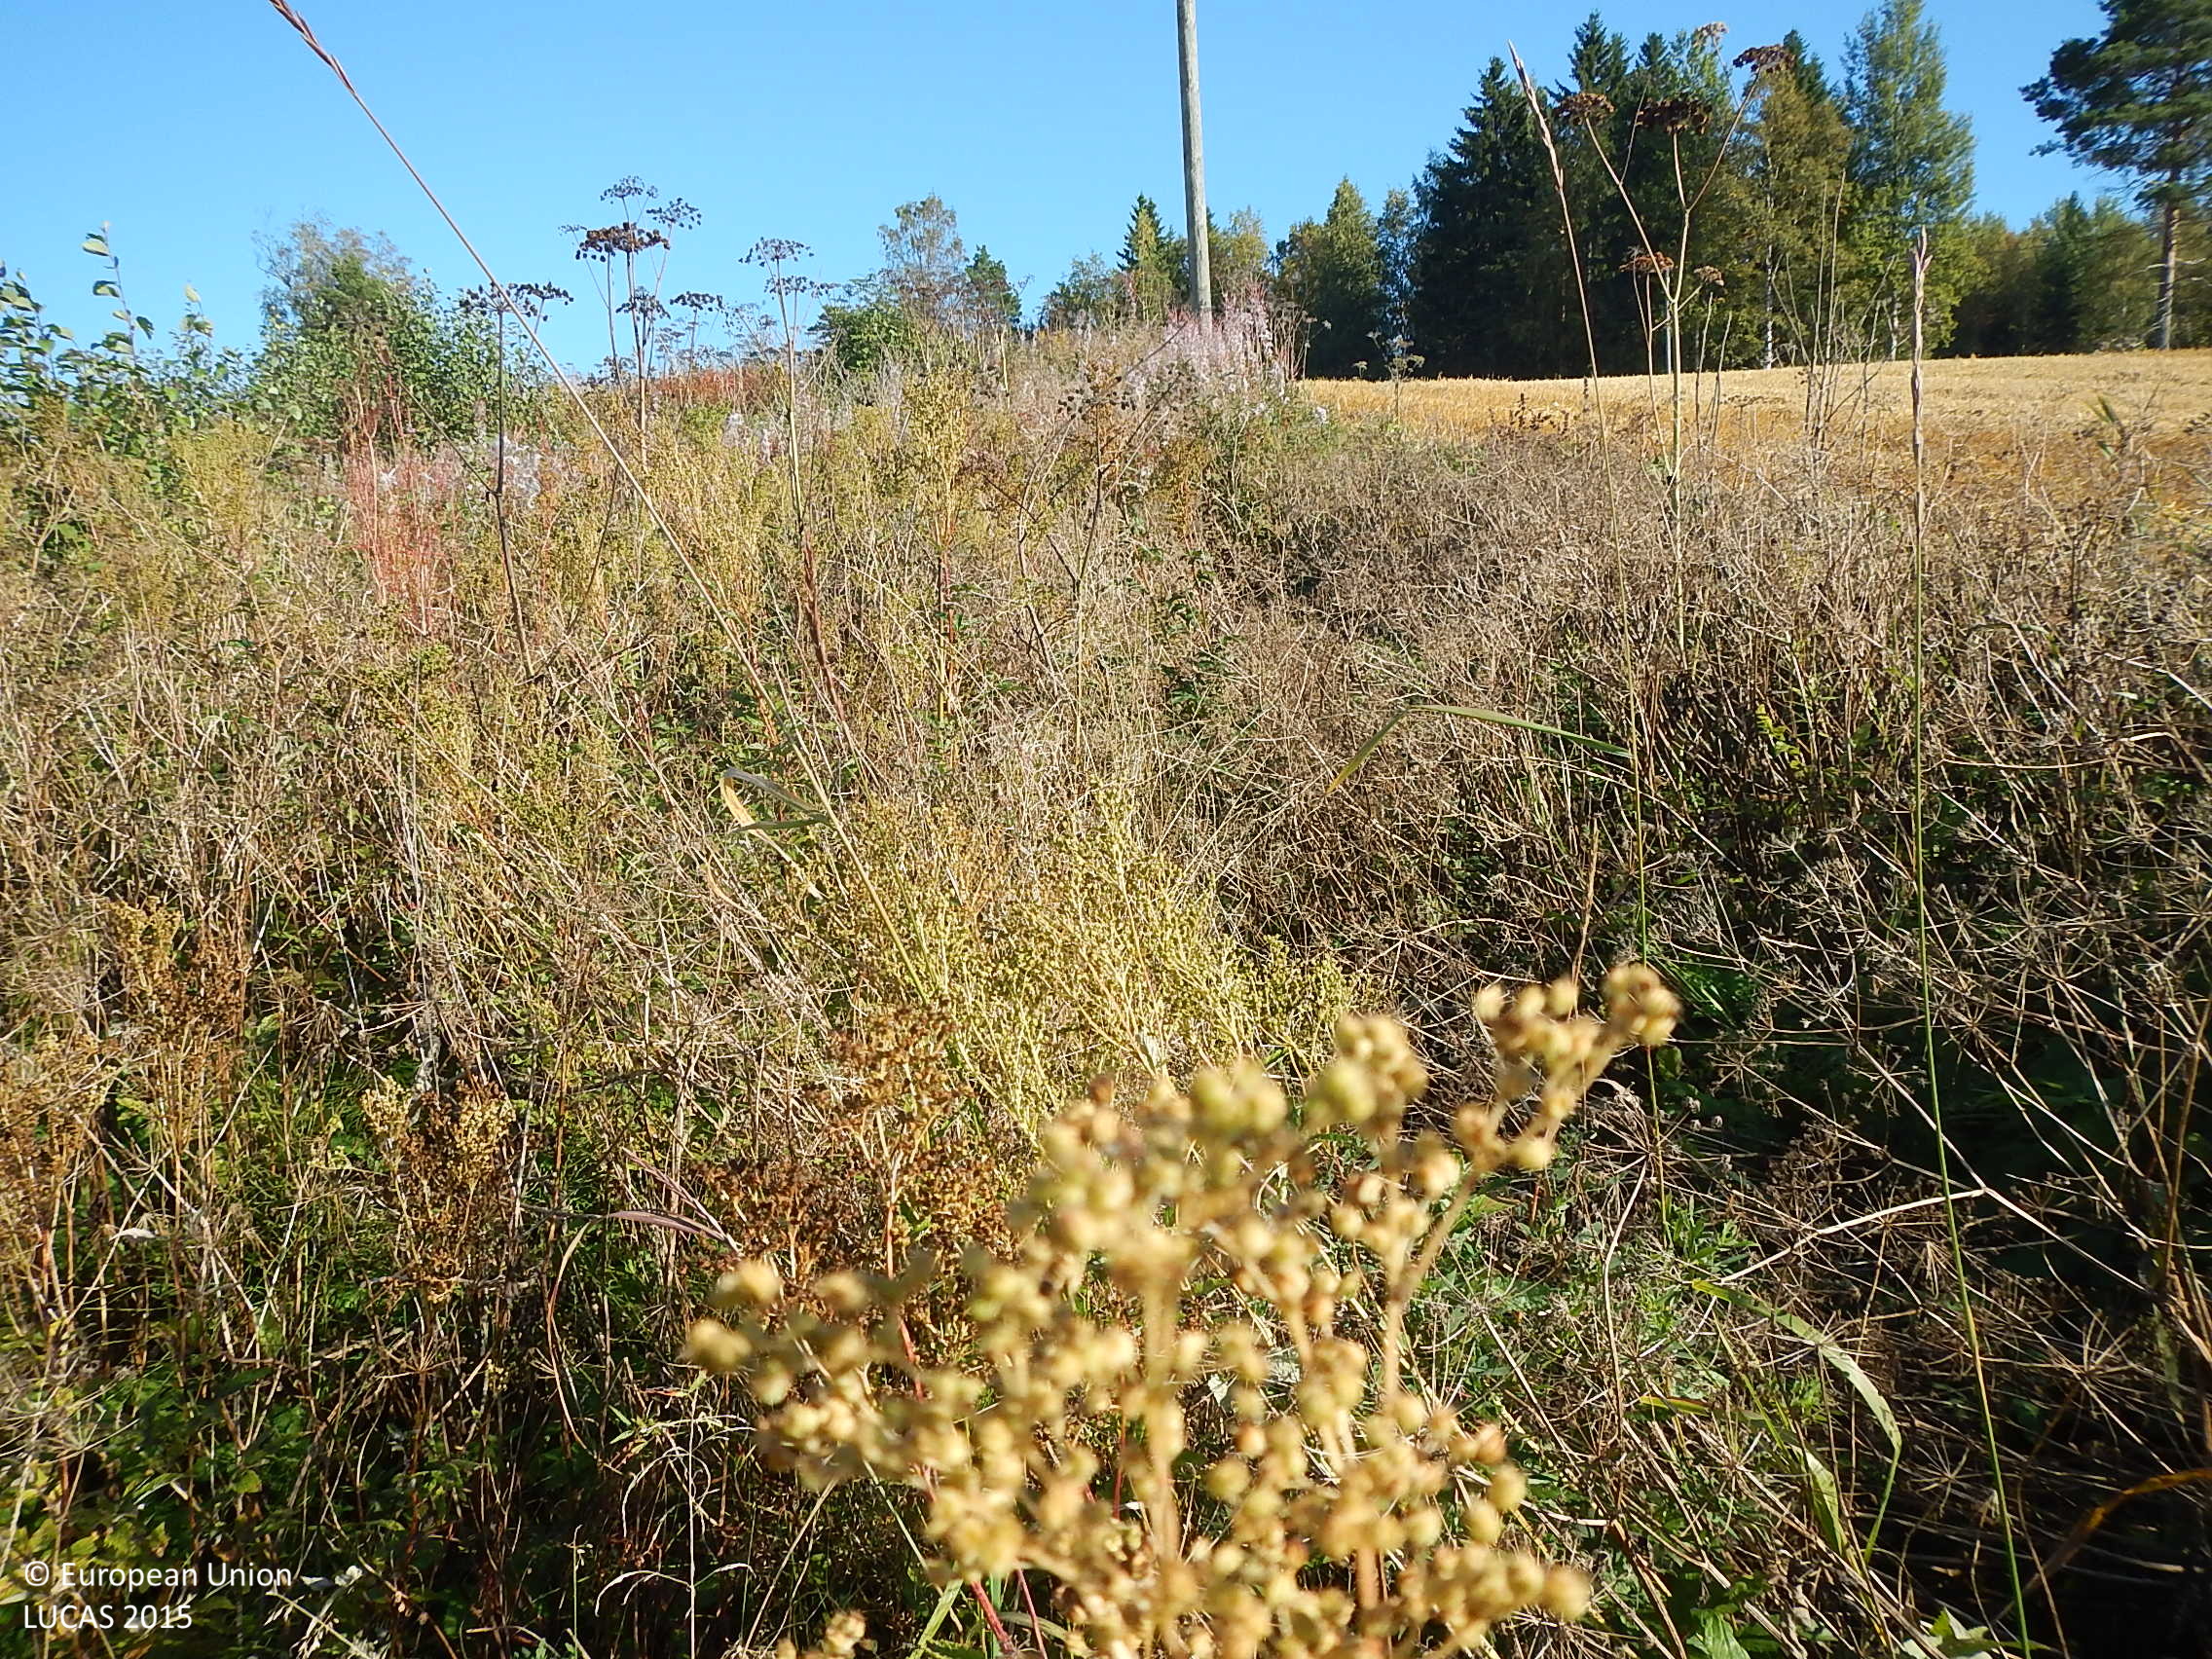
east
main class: Grassland
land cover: Spontaneously vegetated surfaces
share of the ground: > 75 %
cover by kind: herbaceous plants 100 %
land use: Semi-natural and natural areas not in use
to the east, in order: Spontaneously vegetated surfaces; Electric lines; Spontaneously vegetated surfaces; Grassland without tree/shrub cover; Tracks; Grass margins; Artificial constructions in urban areas; Grassland without tree/shrub cover; Ditches and canals; Spontaneously vegetated surfaces; Ditches and canals; Broadleaved woodland; Spontaneously vegetated surfaces; Spruce dominated mixed woodland
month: September
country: FI
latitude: 61.6450
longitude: 22.7690
